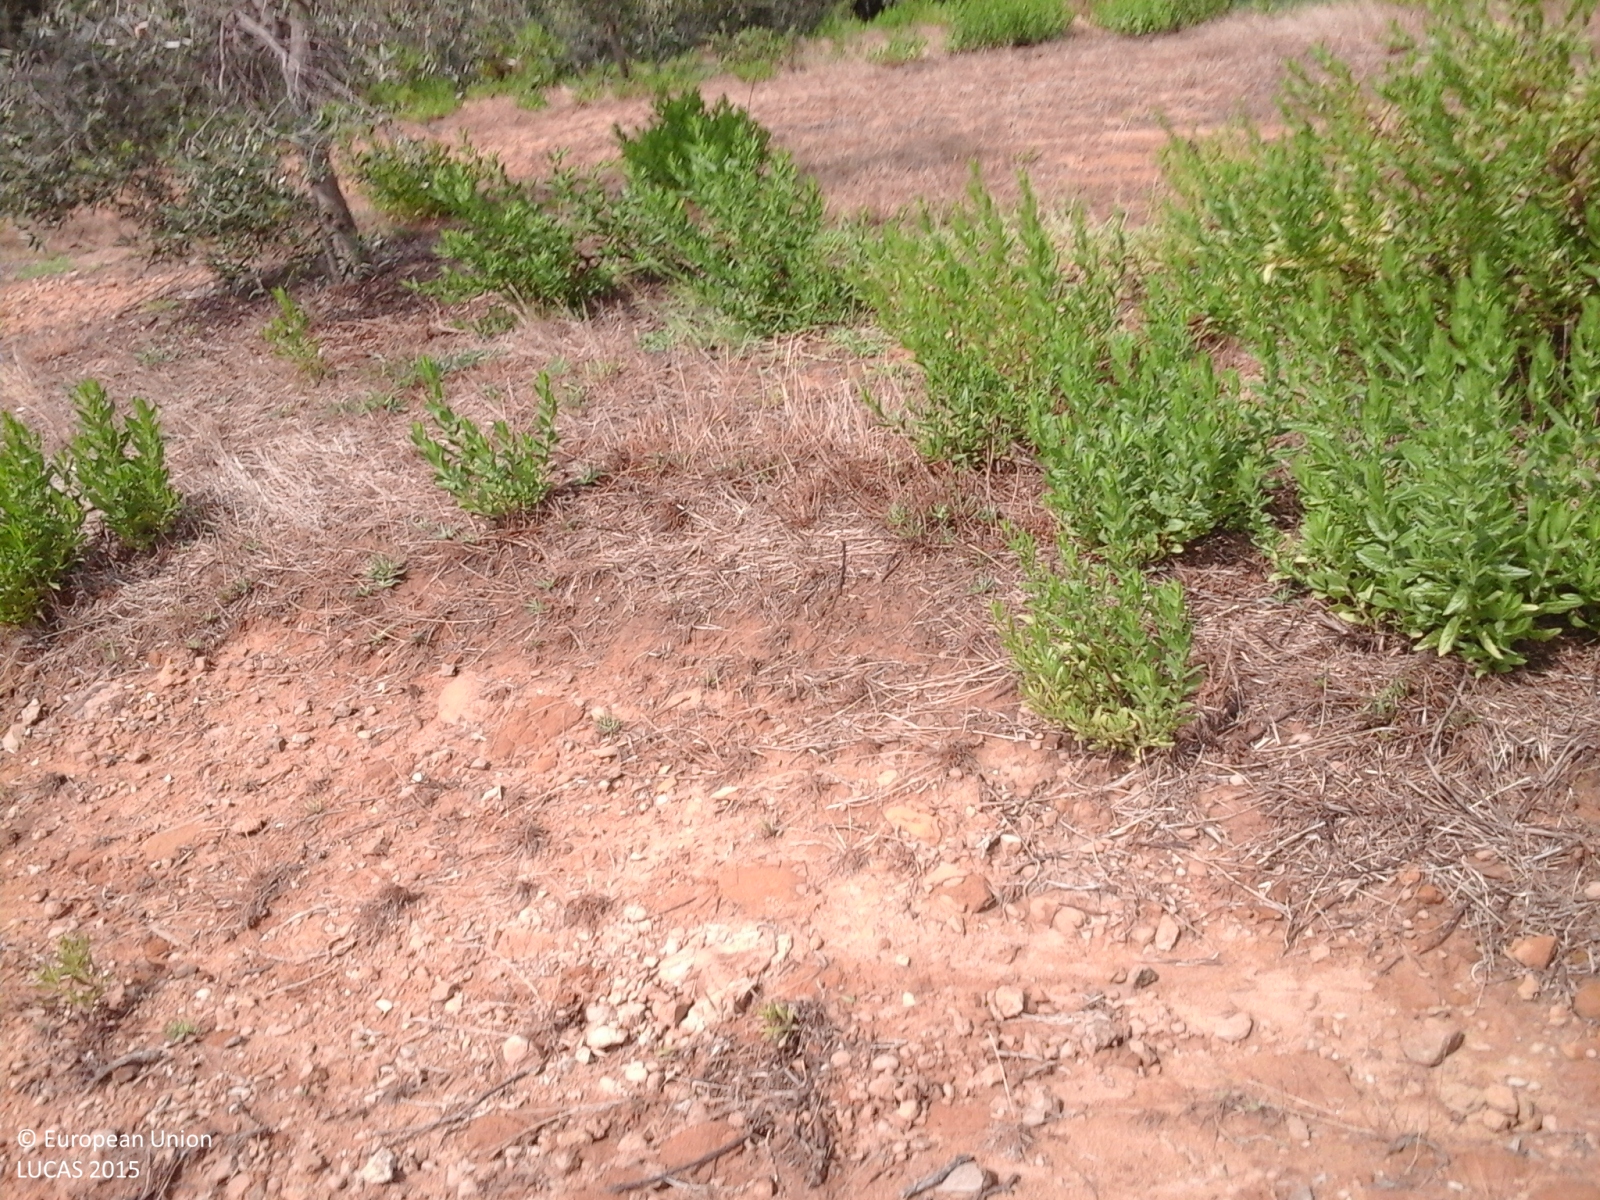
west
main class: Cropland
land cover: Olive groves
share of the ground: 50 - 75 %
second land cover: Spontaneously vegetated surfaces
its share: 25 - 50 %
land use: Agriculture (excluding fallow land and kitchen gardens)
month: August
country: IT
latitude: 42.8844
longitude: 10.9398
